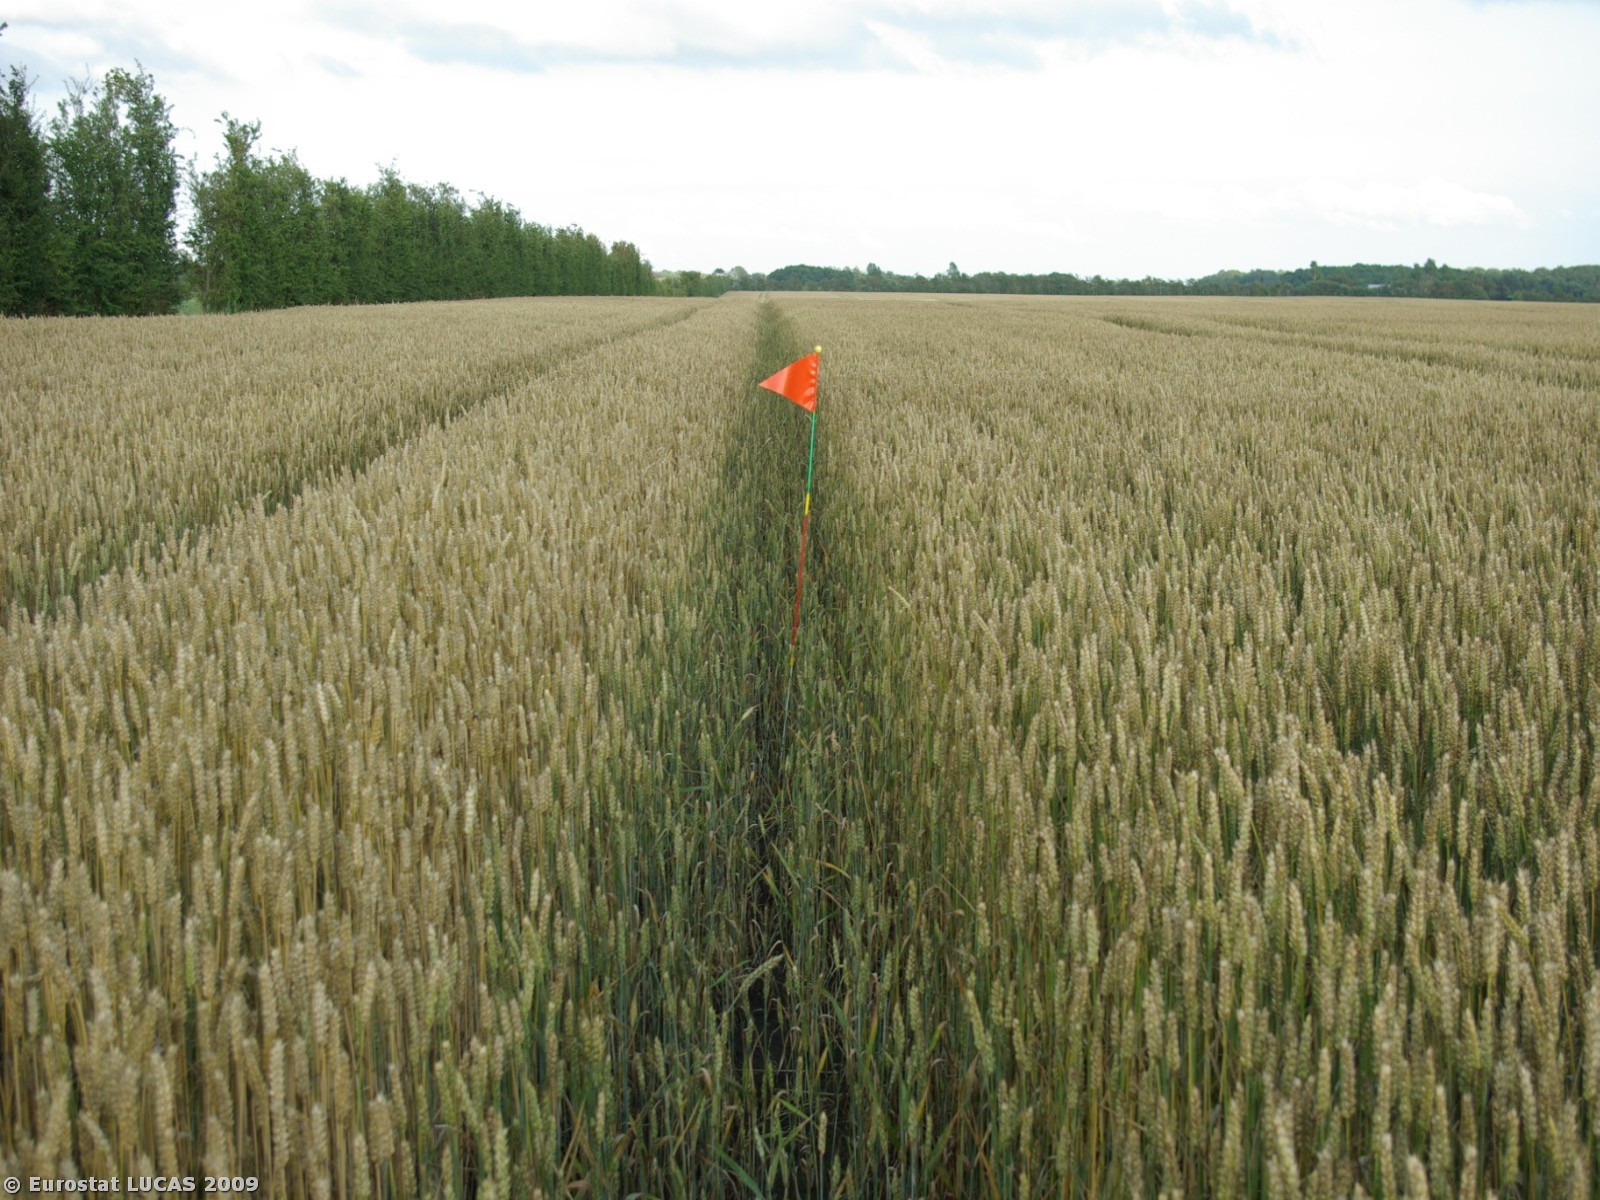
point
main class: Cropland
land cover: Common wheat
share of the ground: > 75 %
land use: Agriculture (excluding fallow land and kitchen gardens)
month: July
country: DK
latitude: 55.1414
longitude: 9.0125
